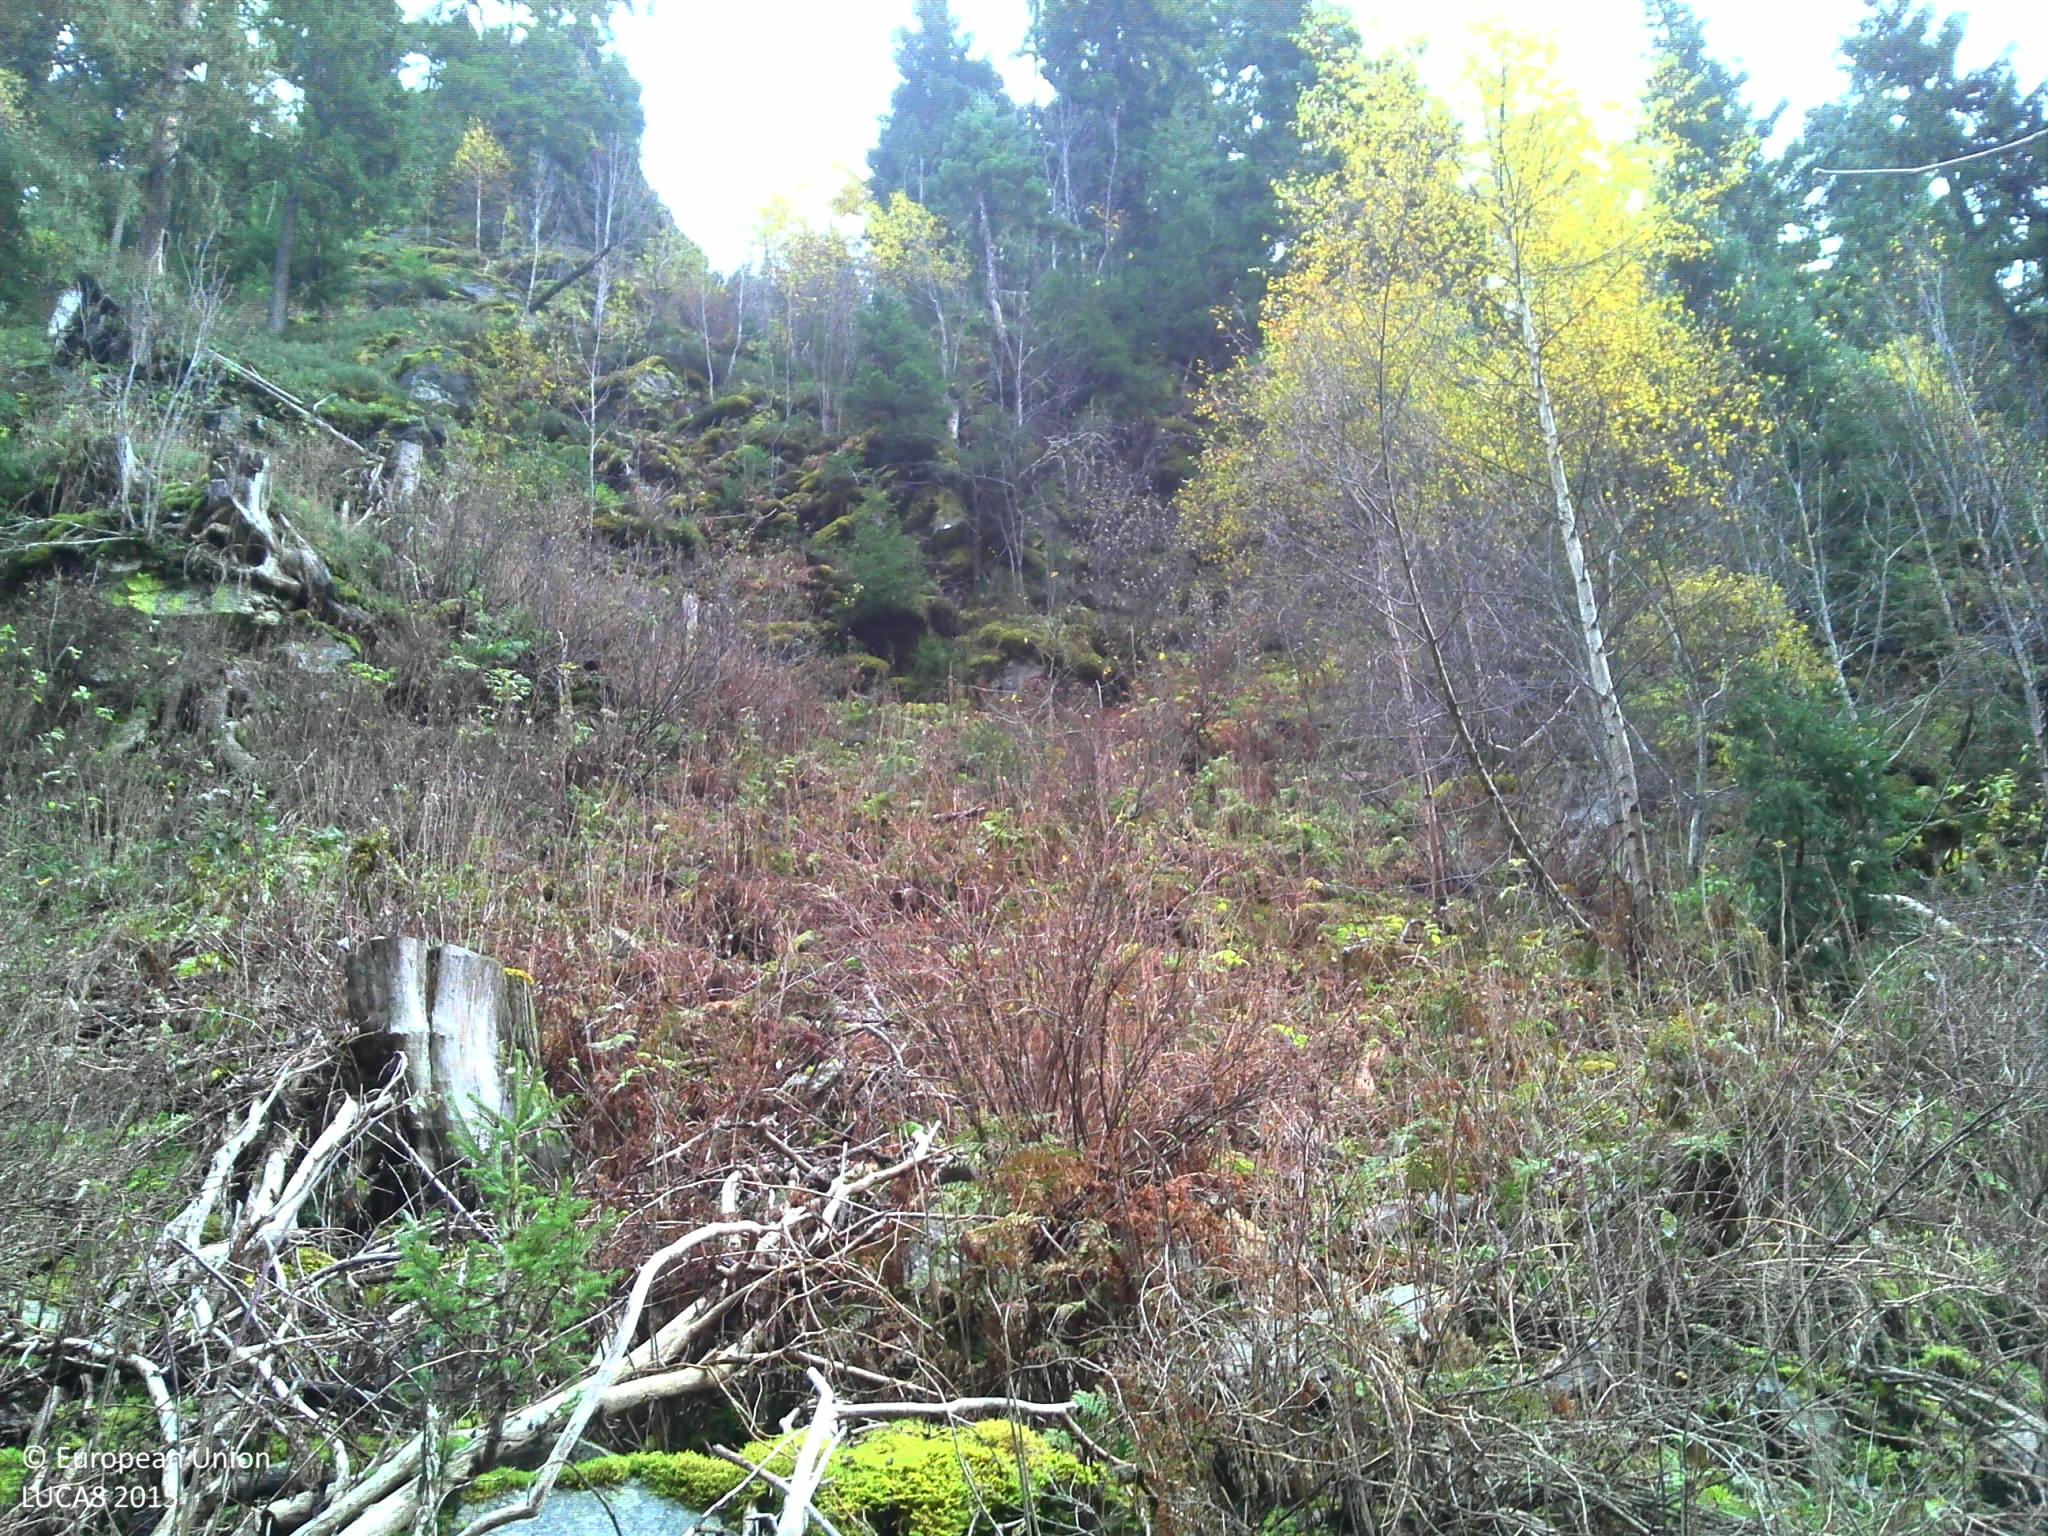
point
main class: Woodland
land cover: Spruce dominated mixed woodland
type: alpine coniferous forest
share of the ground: > 75 %
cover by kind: coniferous forest trees 55 %, broadleaved forest trees 35 %, consolidated bare surface 10 %
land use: Forestry
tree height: > 5 m
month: October
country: FR
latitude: 45.5729
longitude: 6.5062
